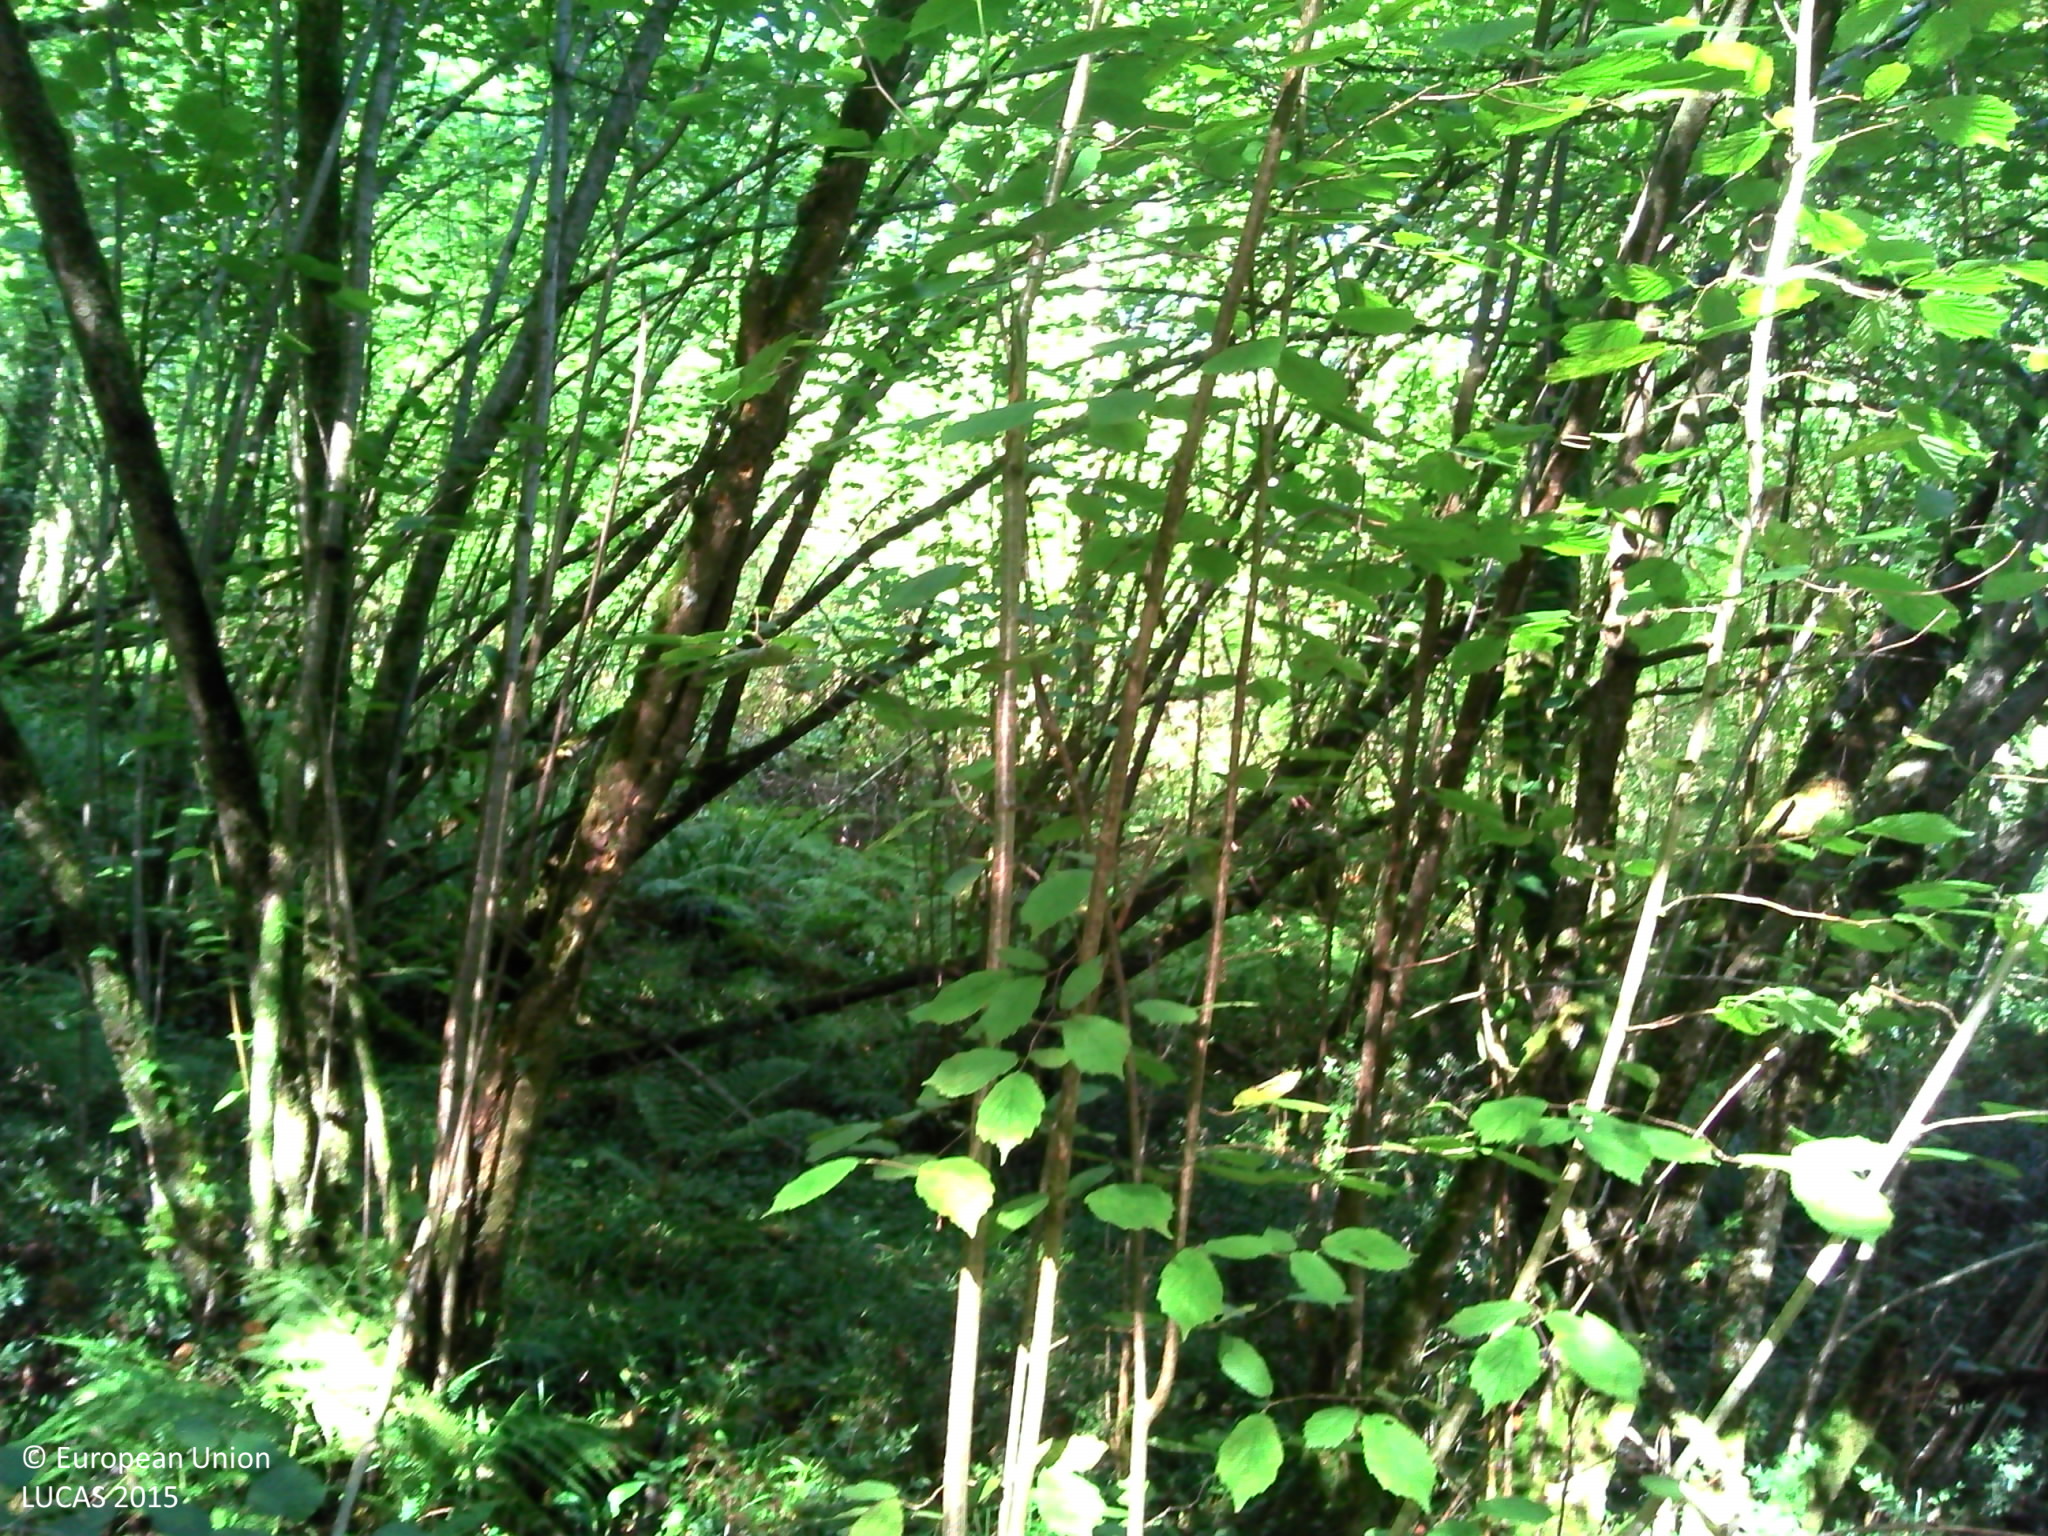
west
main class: Woodland
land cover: Broadleaved woodland
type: mesophytic deciduous forest
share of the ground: > 75 %
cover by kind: broadleaved forest trees 80 %, lichens and mosses 10 %, shrubs 5 %, herbaceous plants 5 %
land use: Forestry
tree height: > 5 m
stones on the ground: < 10 %
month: September
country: FR
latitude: 43.4629
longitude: -0.7519
